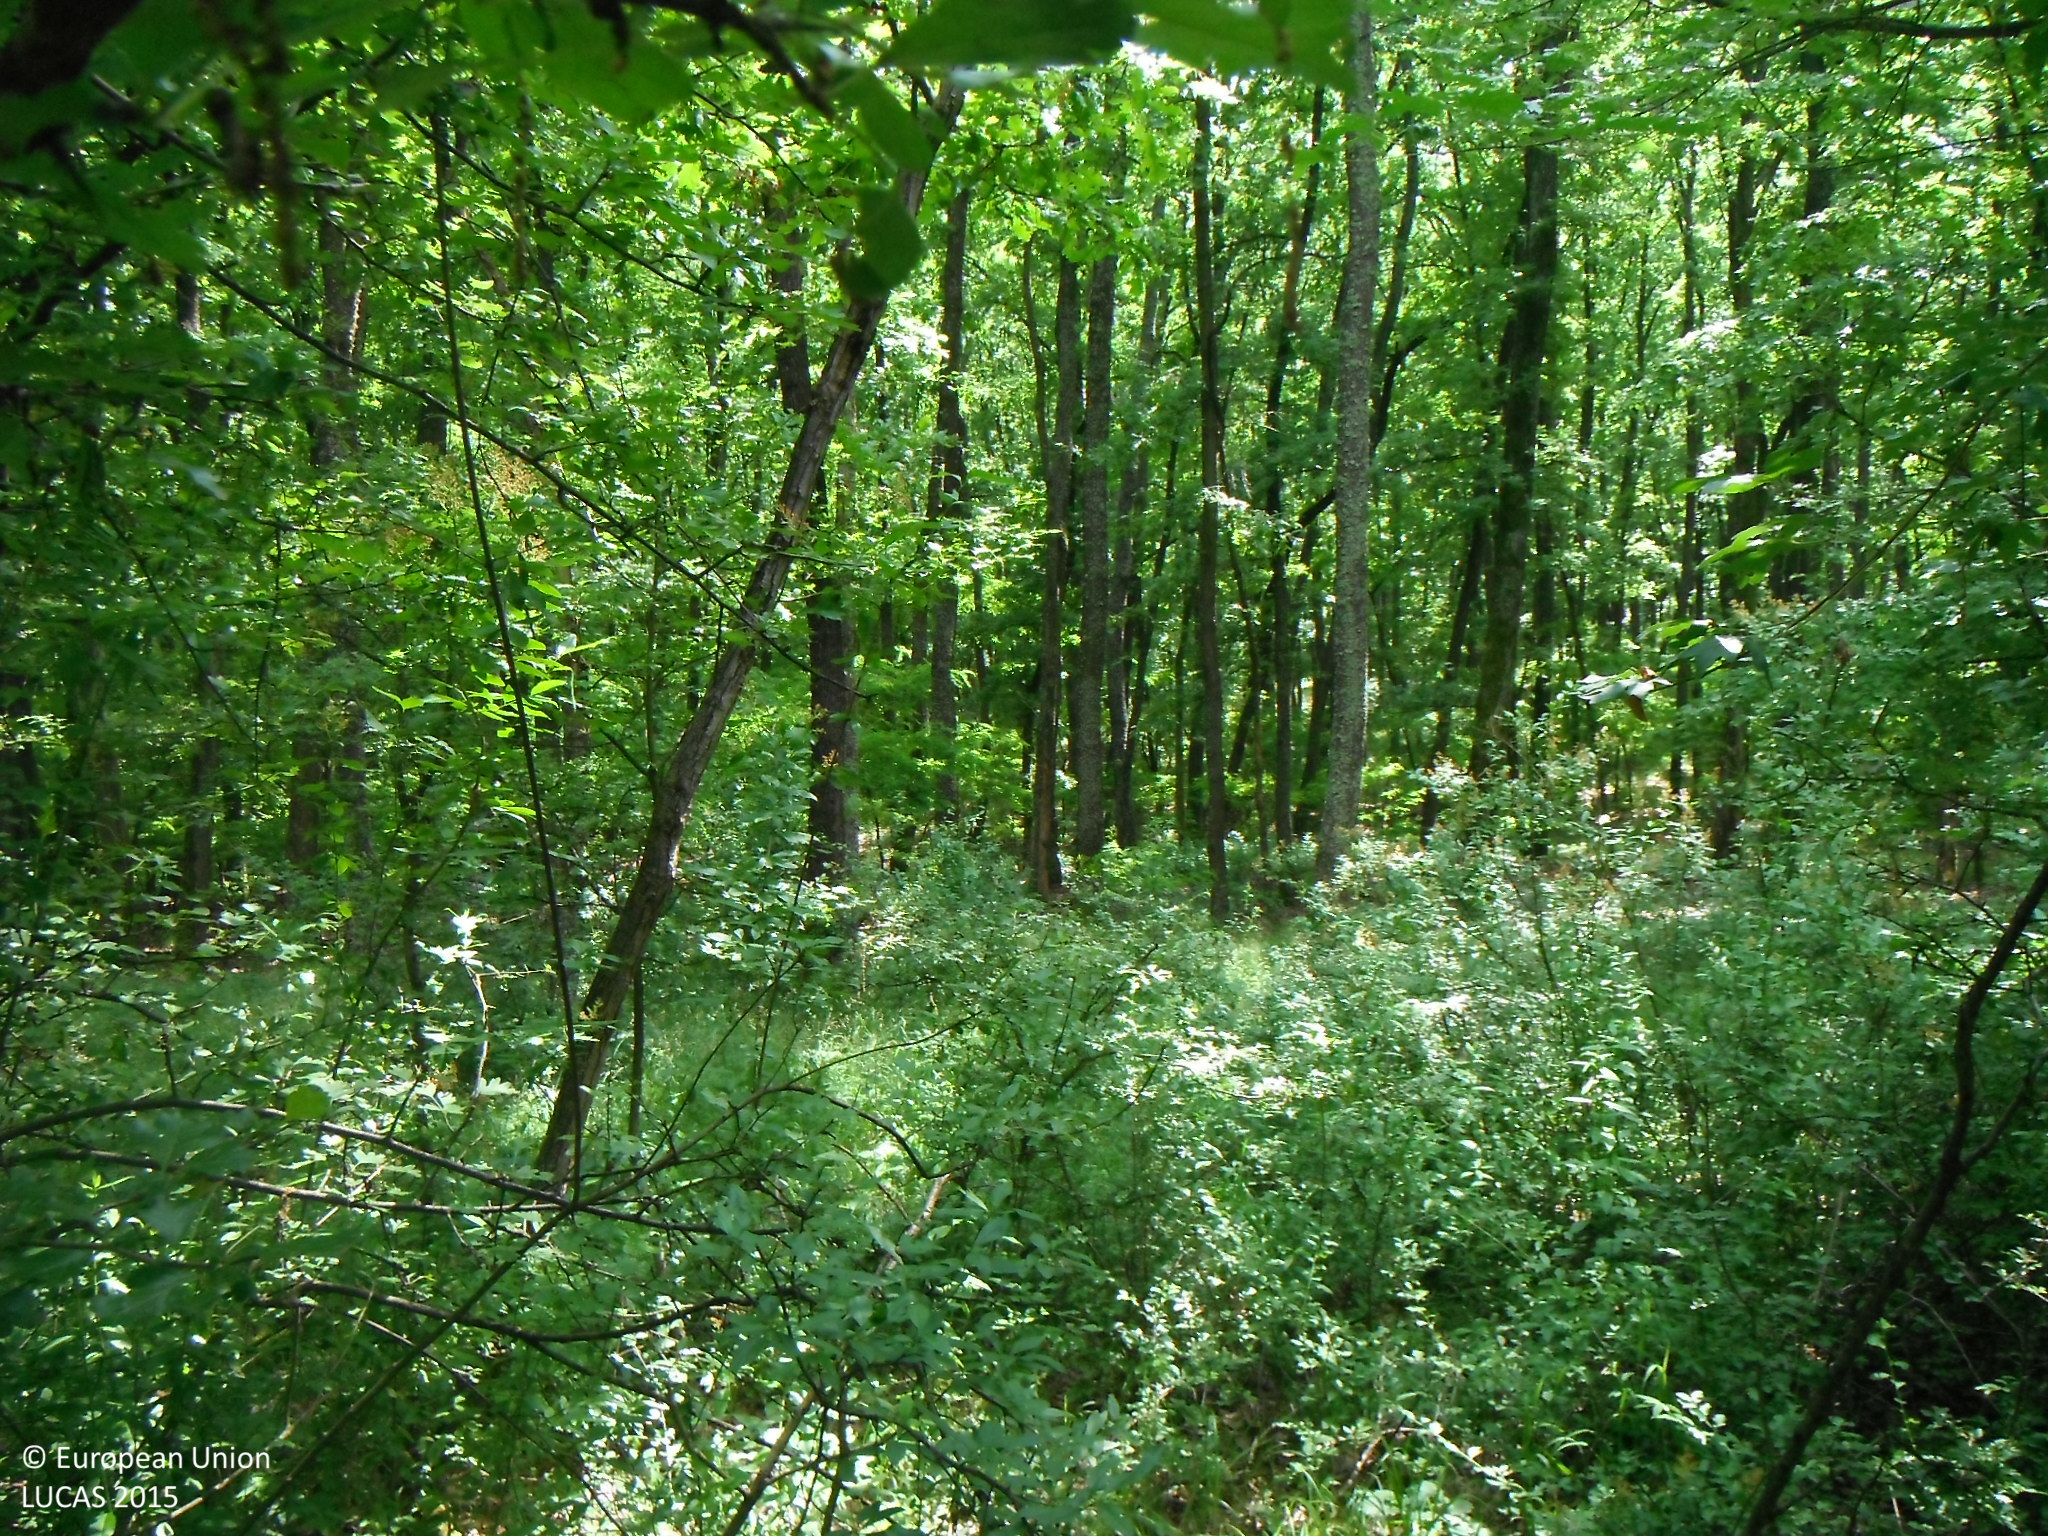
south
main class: Woodland
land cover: Broadleaved woodland
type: acidophilous oak and oak-birch forest
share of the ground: > 75 %
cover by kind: broadleaved forest trees 80 %, shrubs 15 %, herbaceous plants 5 %
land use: Forestry
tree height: > 5 m
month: June
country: SK
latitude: 48.3015
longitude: 19.5016
